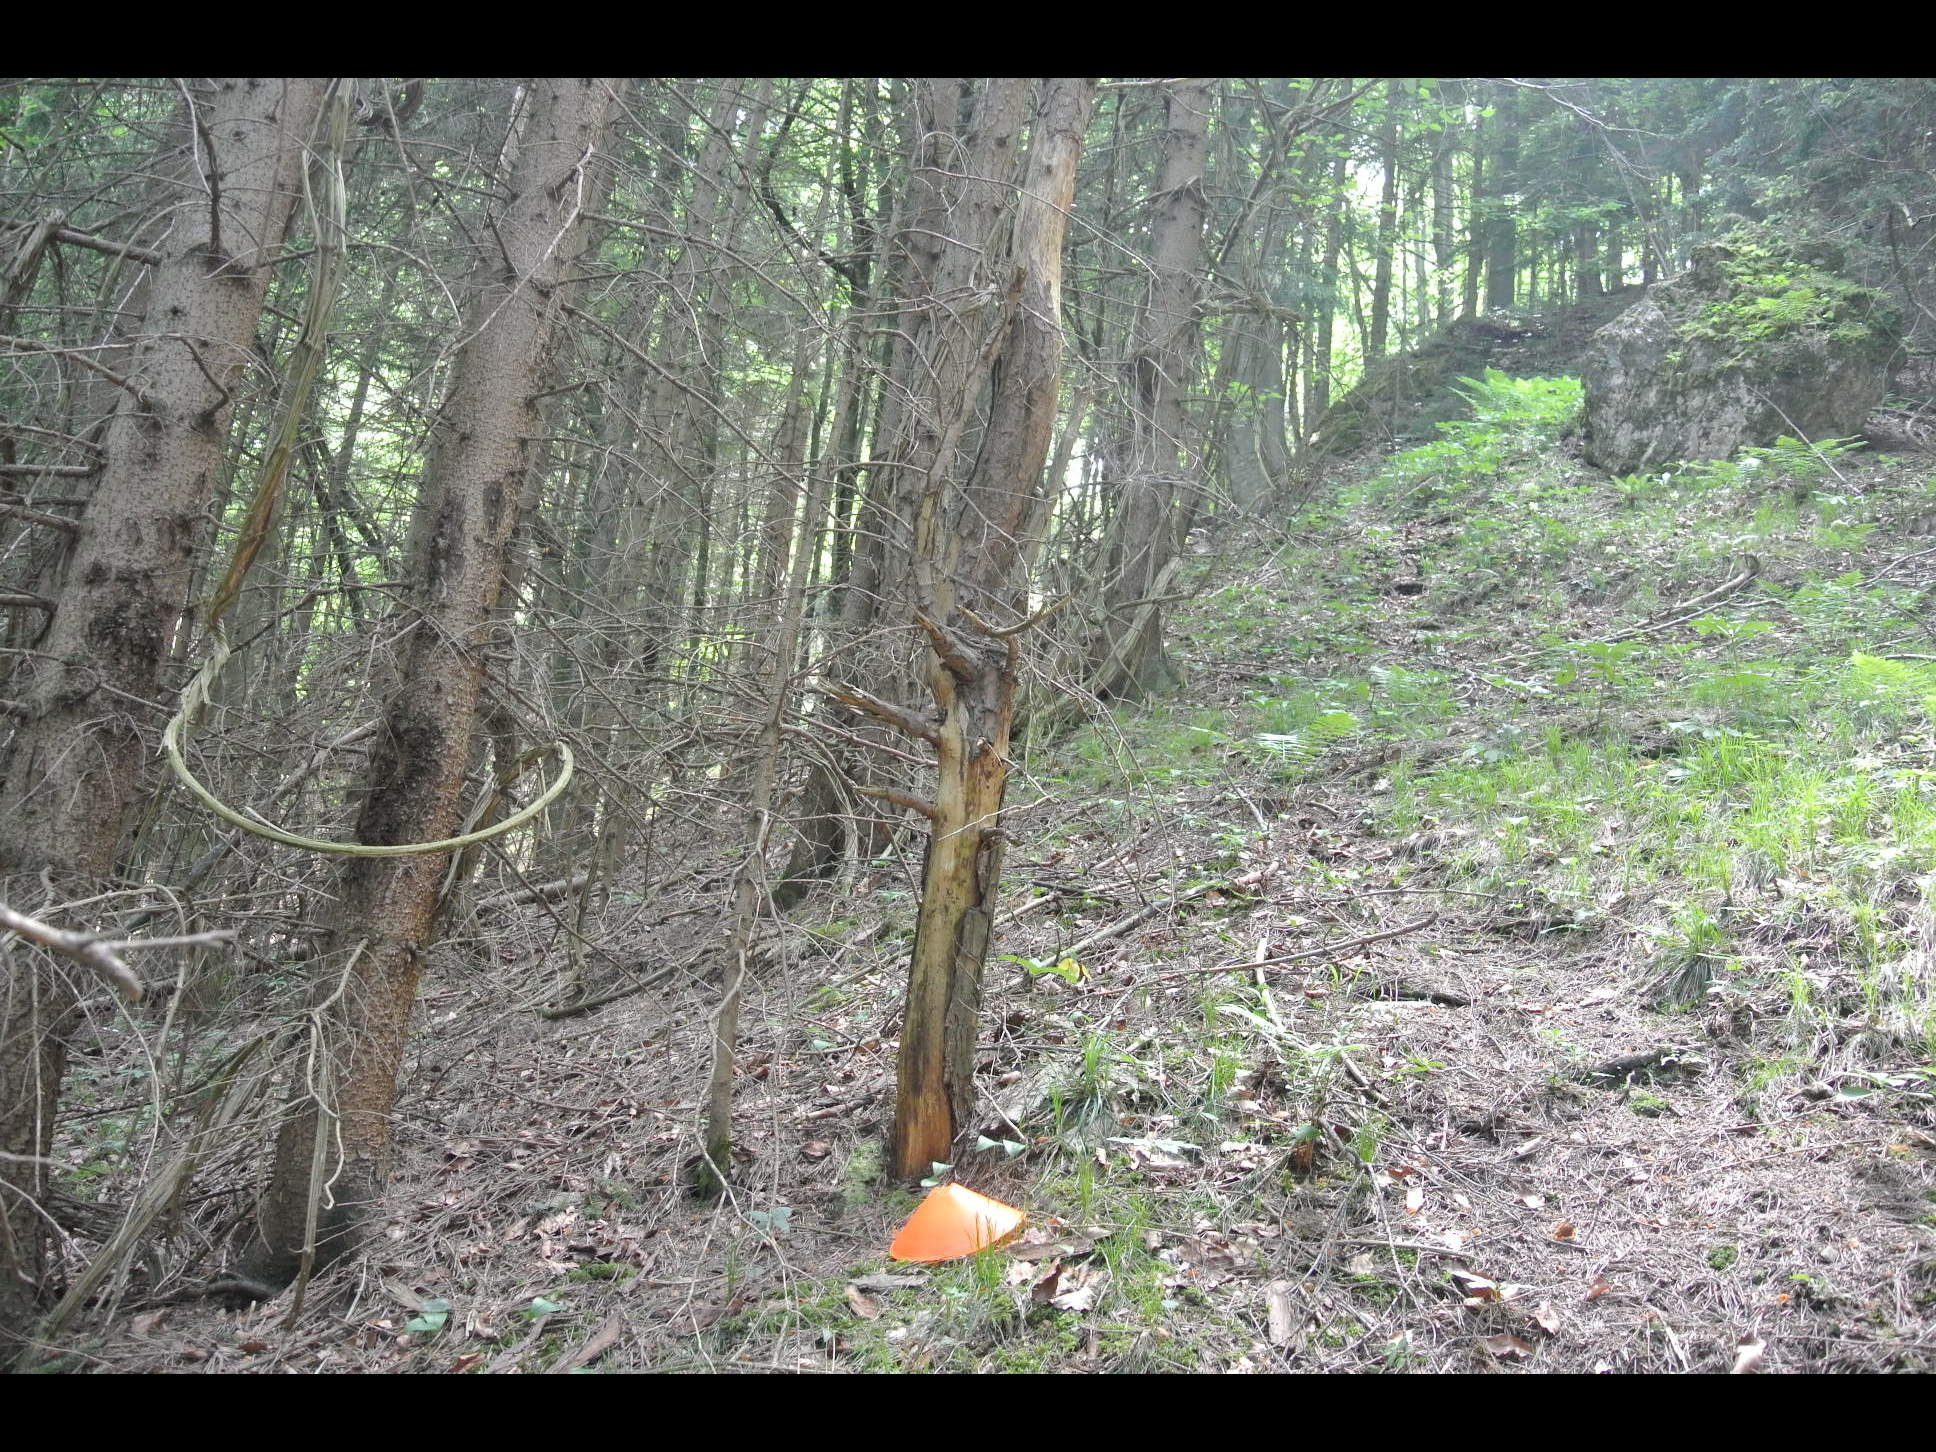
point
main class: Woodland
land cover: Spruce dominated coniferous woodland
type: alpine coniferous forest
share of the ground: > 75 %
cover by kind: coniferous forest trees 95 %, broadleaved forest trees 5 %
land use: Forestry
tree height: > 5 m
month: May
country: AT
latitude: 47.9970
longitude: 15.8326
